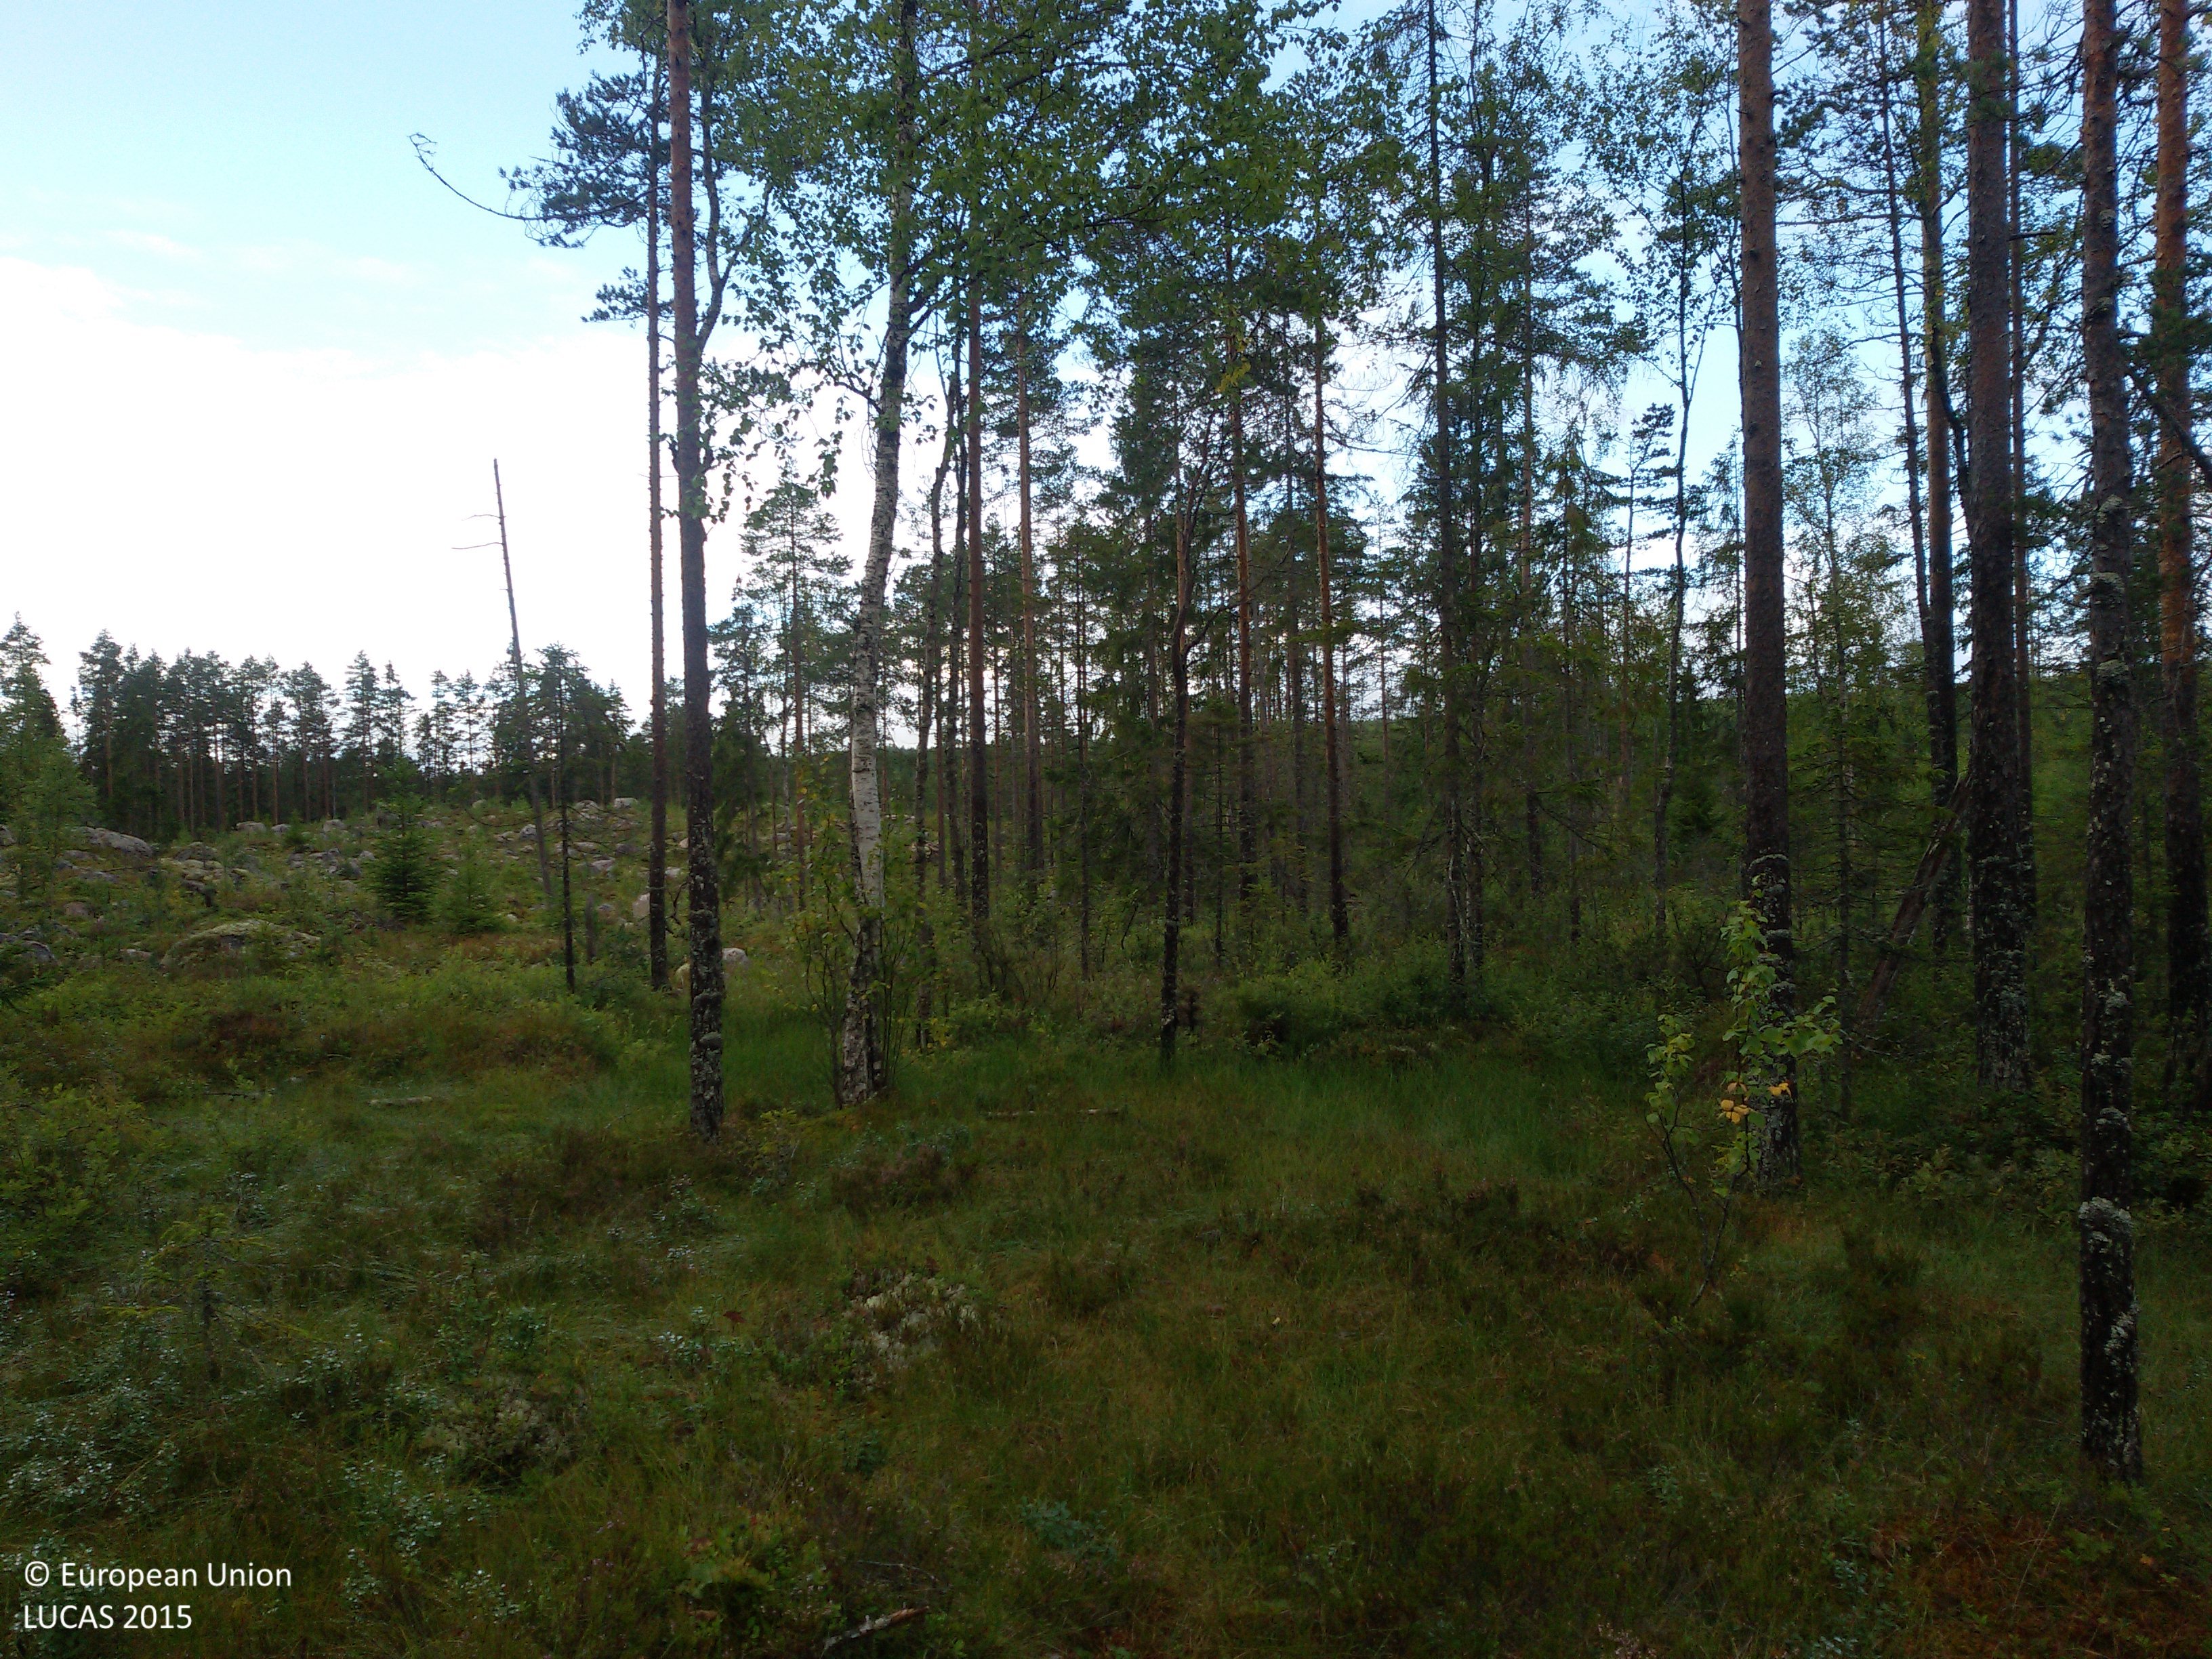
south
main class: Woodland
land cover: Pine dominated mixed woodland
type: boreal forest
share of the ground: 50 - 75 %
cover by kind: herbaceous plants 40 %, coniferous forest trees 30 %, broadleaved forest trees 30 %
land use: Forestry
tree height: > 5 m
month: September
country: SE
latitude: 61.0724
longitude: 15.3417
